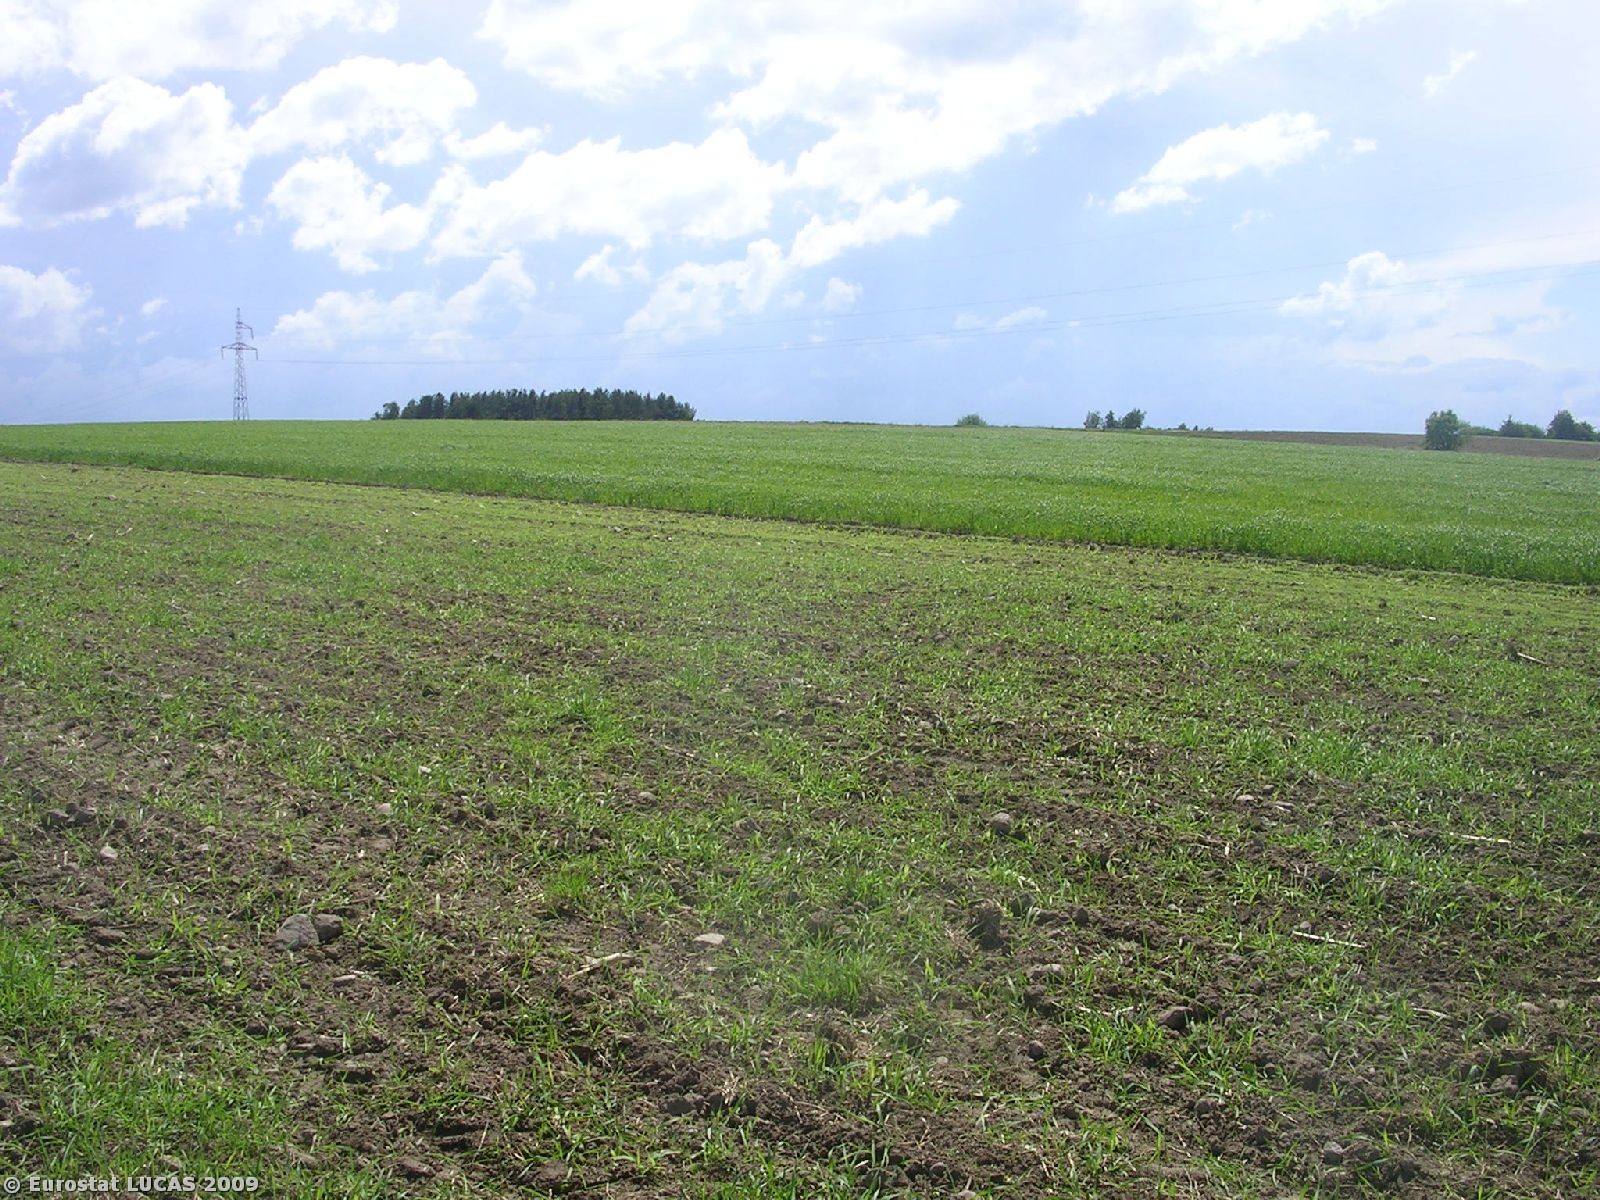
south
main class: Cropland
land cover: Maize
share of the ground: 10 - 25 %
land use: Agriculture (excluding fallow land and kitchen gardens)
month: May
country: PL
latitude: 53.5665
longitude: 23.3836
